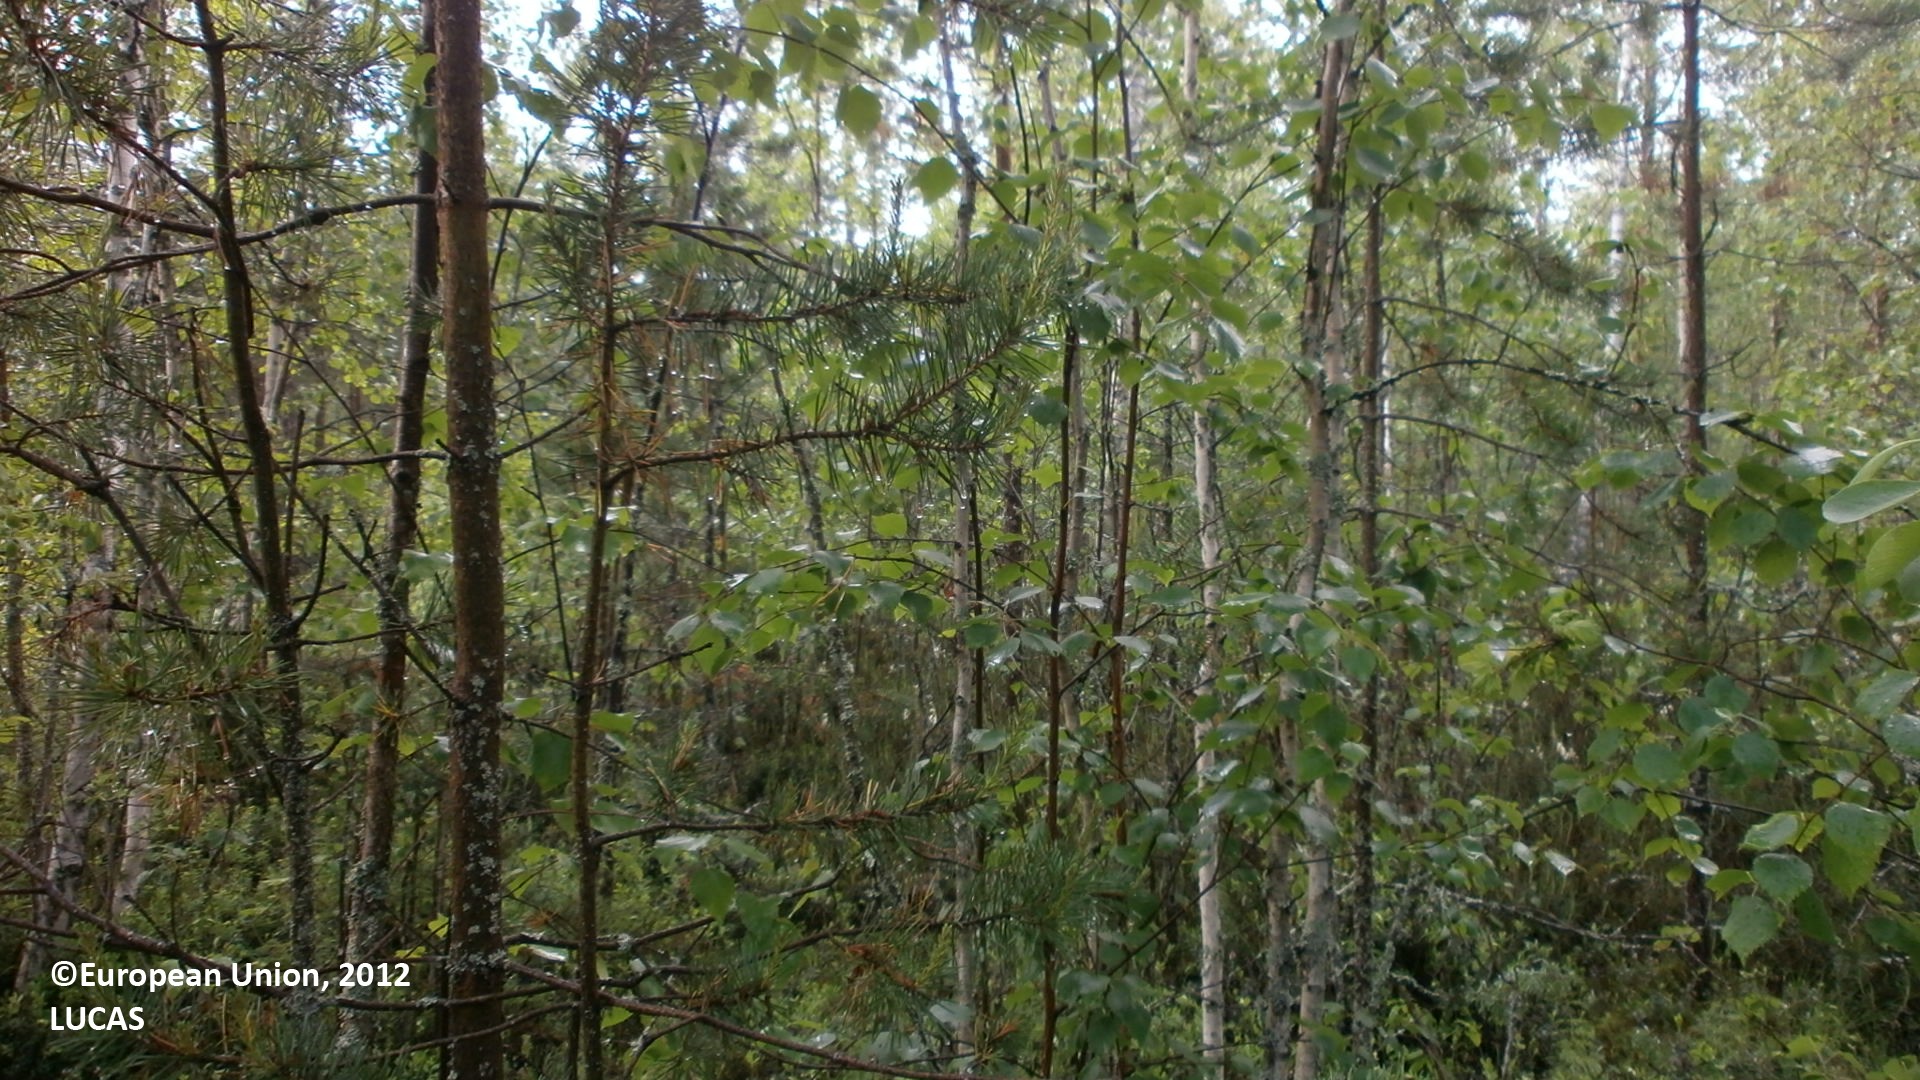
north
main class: Woodland
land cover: Broadleaved woodland
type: boreal forest
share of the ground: > 75 %
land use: Forestry
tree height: > 5 m
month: June
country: FI
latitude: 64.7861
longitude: 25.2068
